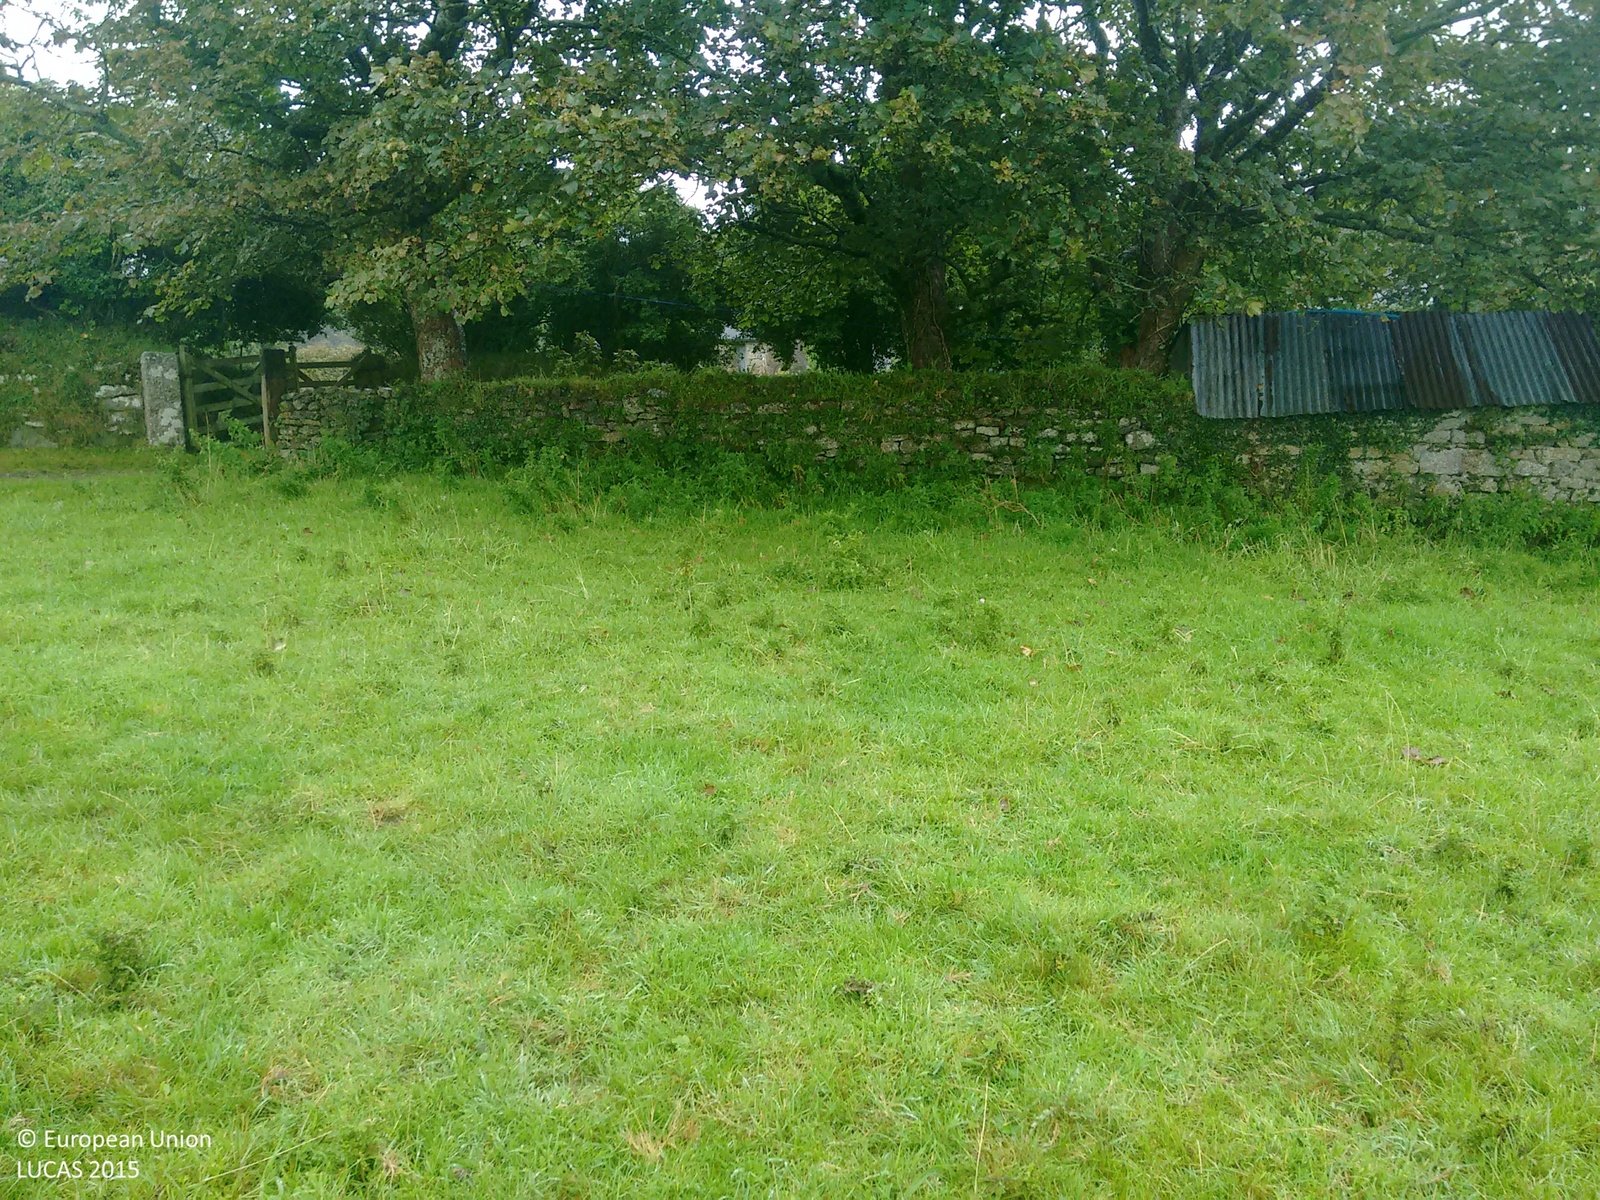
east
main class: Grassland
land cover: Grassland without tree/shrub cover
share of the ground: > 75 %
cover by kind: herbaceous plants 100 %
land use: Agriculture (excluding fallow land and kitchen gardens)
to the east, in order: Grassland without tree/shrub cover; Single bushes/trees; Tracks; Abandoned hedges; Grassland without tree/shrub cover; Dry stone walls; Grassland without tree/shrub cover; Fences; Broadleaved woodland; Rivers and streams; Broadleaved woodland; Grassland without tree/shrub cover
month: August
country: GB
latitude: 50.1255
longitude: -5.2131
